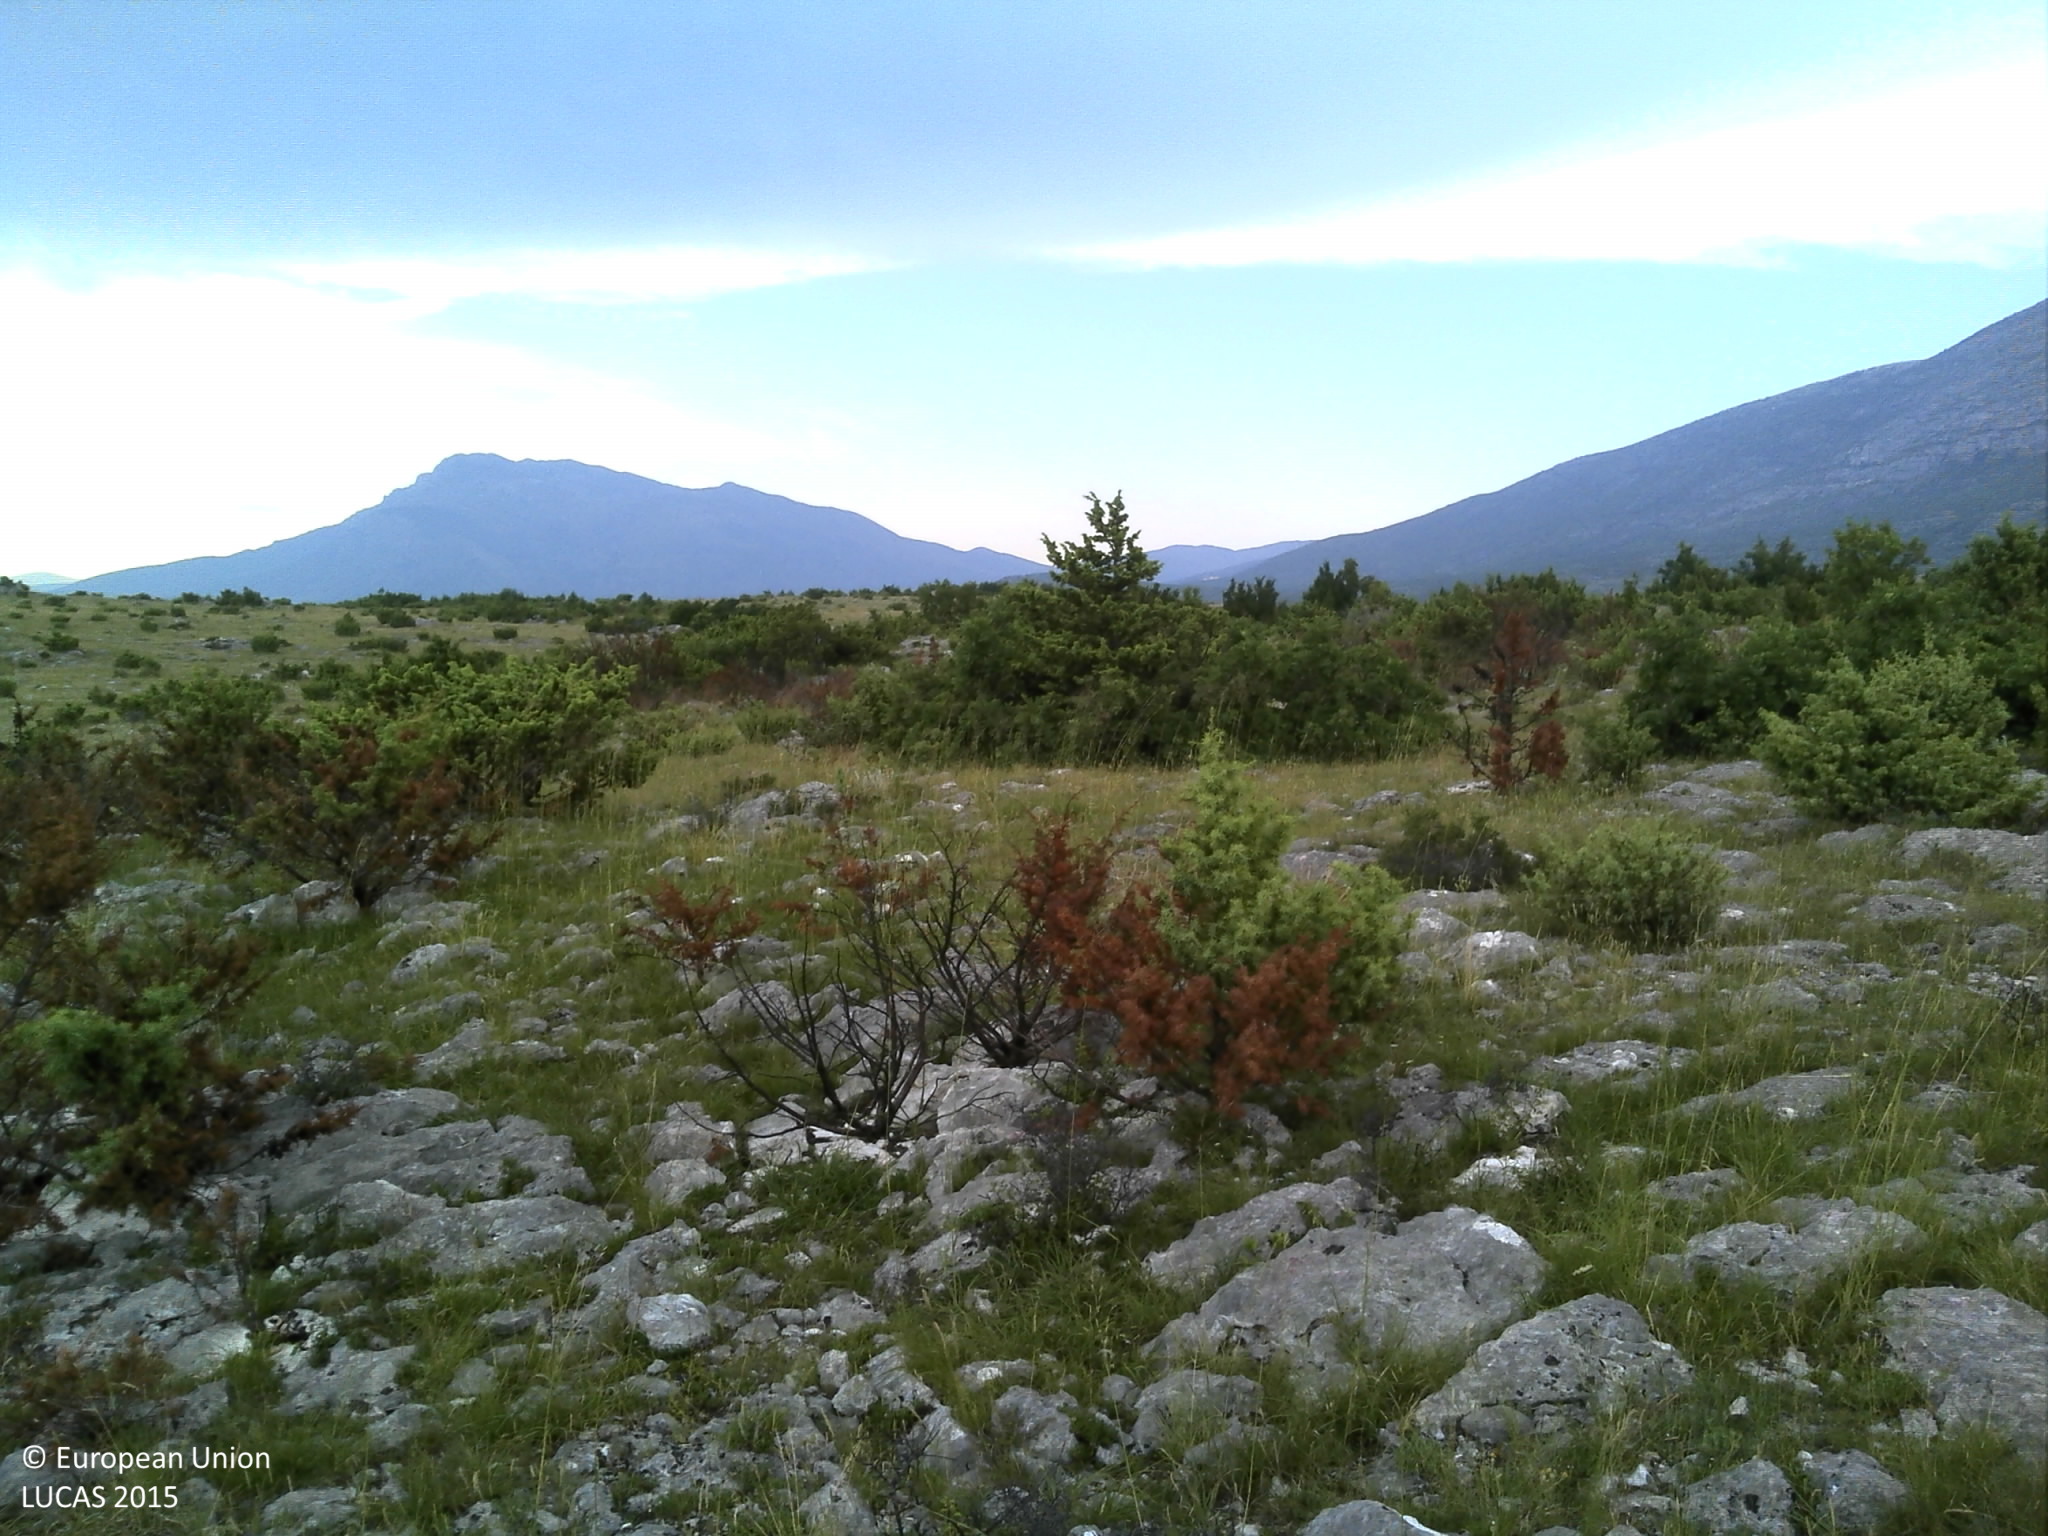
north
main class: Shrubland
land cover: Shrubland with sparse tree cover
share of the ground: 10 - 25 %
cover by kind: herbaceous plants 45 %, shrubs 20 %, unconsolidated bare surface 20 %, consolidated bare surface 10 %, broadleaved forest trees 5 %
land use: Agriculture (excluding fallow land and kitchen gardens)
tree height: < 5 m
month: June
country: HR
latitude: 43.9323
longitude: 16.4575
